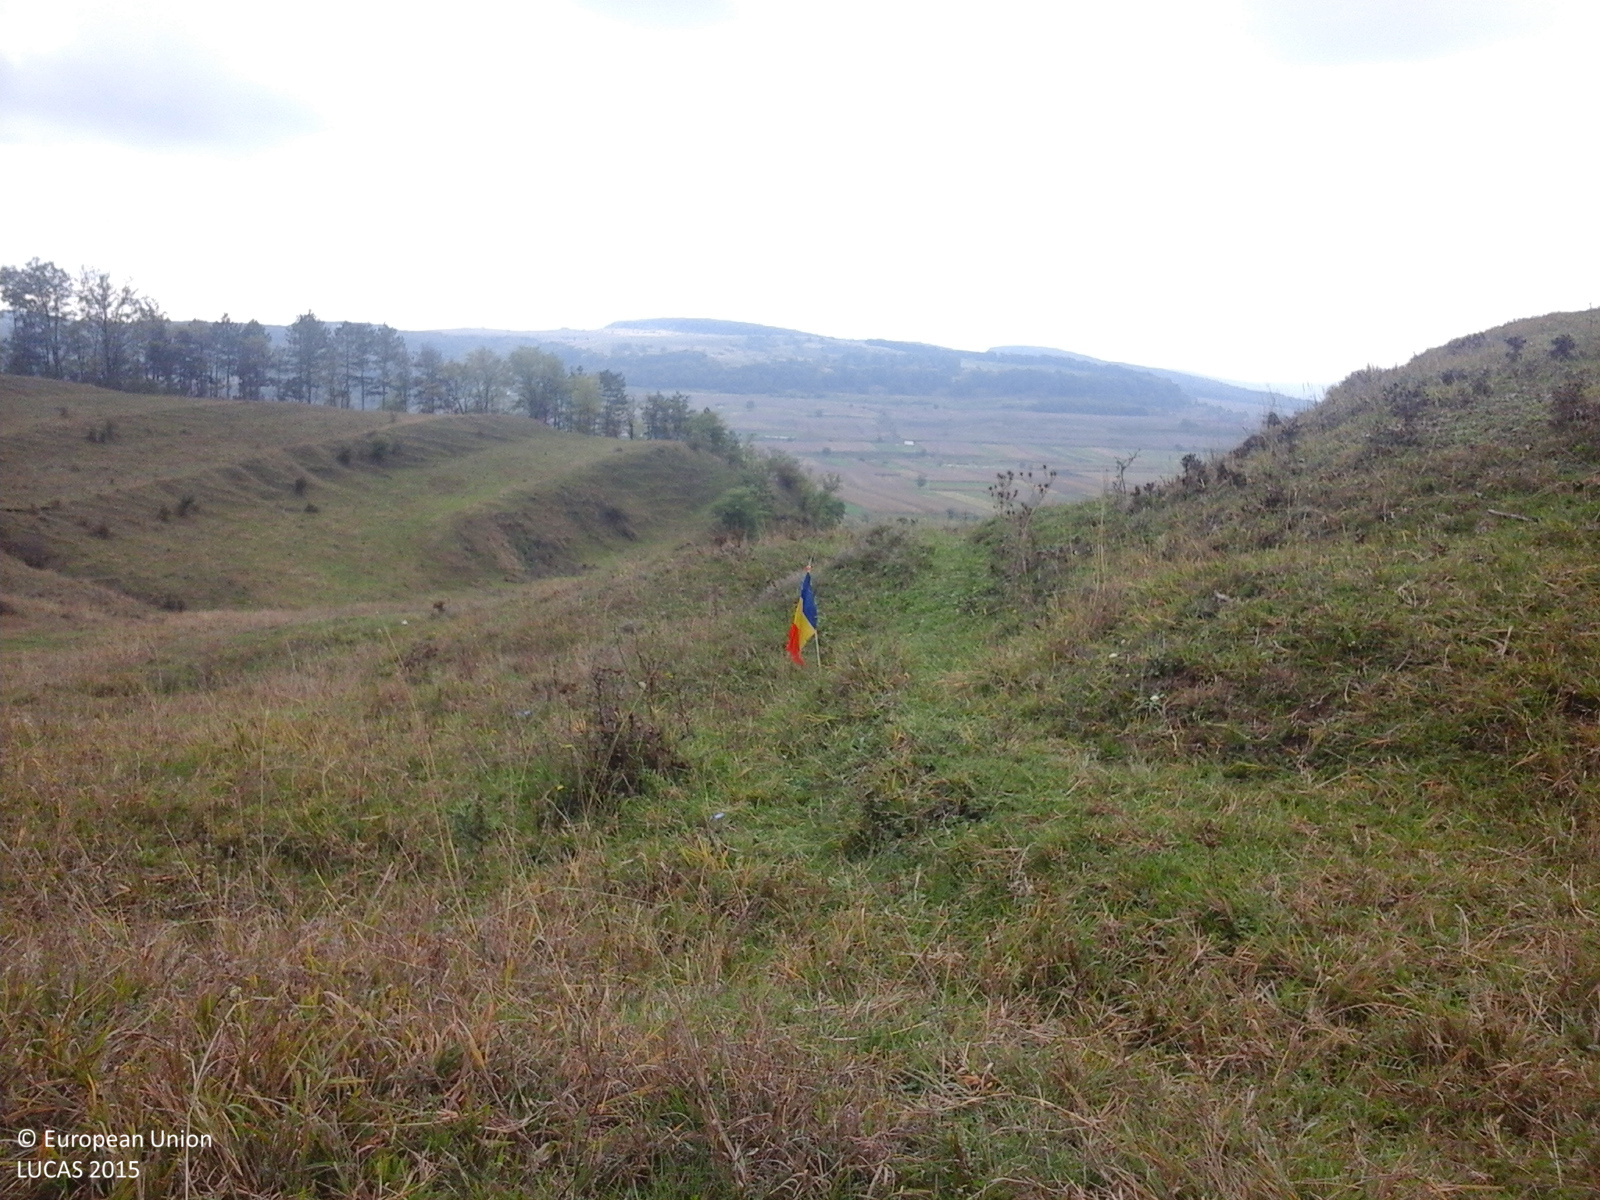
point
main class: Grassland
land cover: Grassland without tree/shrub cover
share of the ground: > 75 %
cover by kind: herbaceous plants 100 %
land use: Agriculture (excluding fallow land and kitchen gardens)
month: October
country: RO
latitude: 46.0899
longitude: 24.0825
